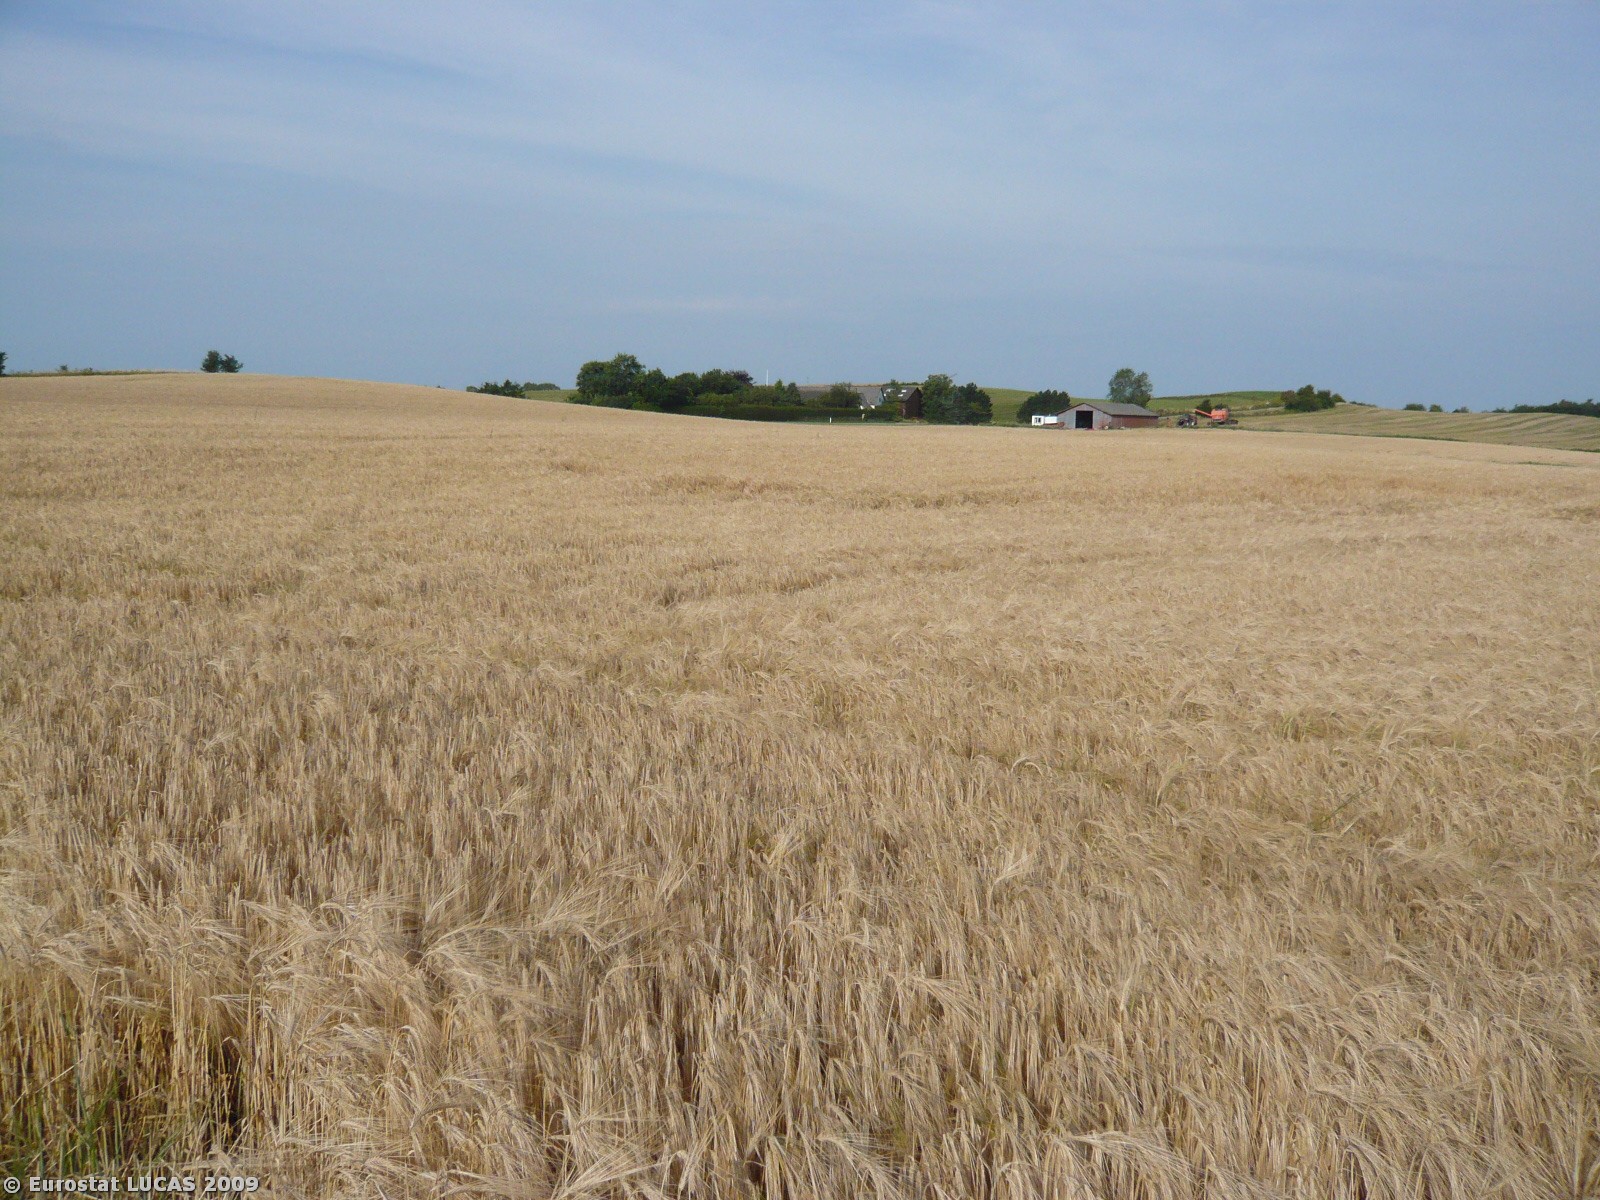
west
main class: Cropland
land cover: Barley
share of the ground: > 75 %
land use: Agriculture (excluding fallow land and kitchen gardens)
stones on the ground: < 10 %
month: August
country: DK
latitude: 55.9897
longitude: 12.1620
